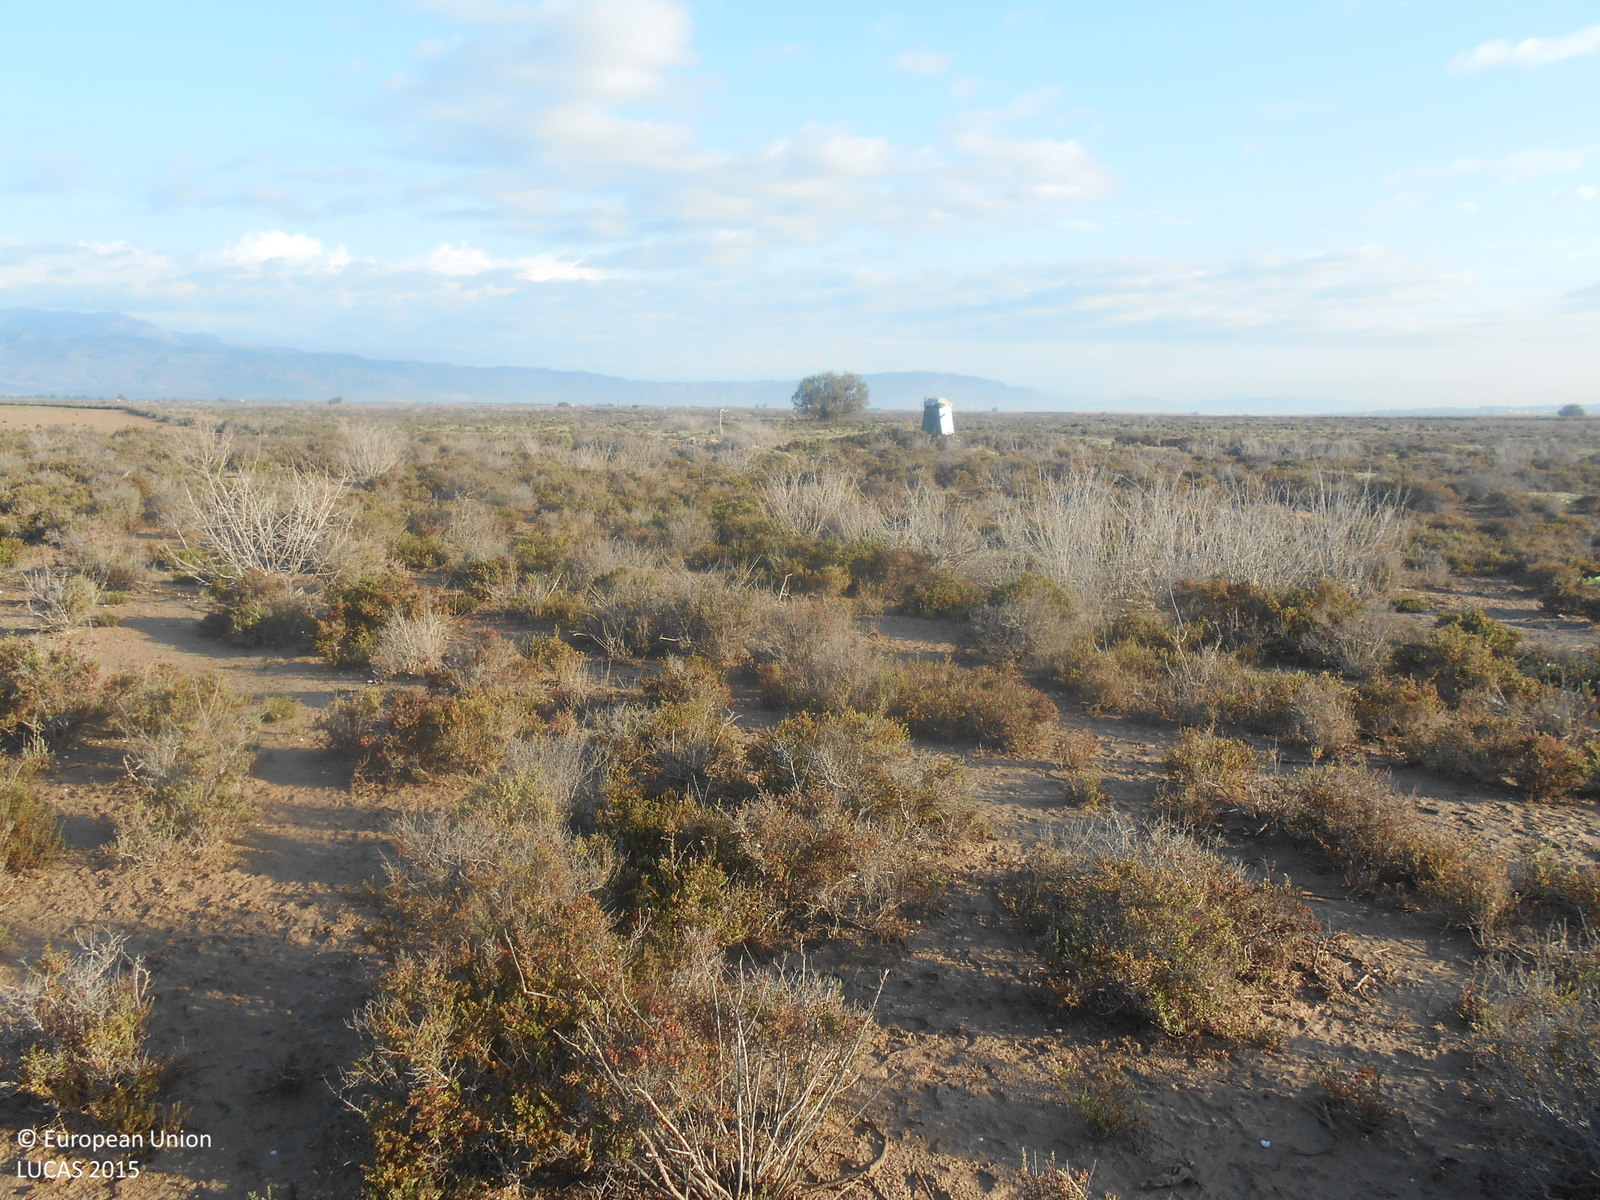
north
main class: Shrubland
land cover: Shrubland without tree cover
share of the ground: 50 - 75 %
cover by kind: shrubs 60 %, unconsolidated bare surface 40 %
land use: Semi-natural and natural areas not in use
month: April
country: ES
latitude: 37.7382
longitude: -1.3863
